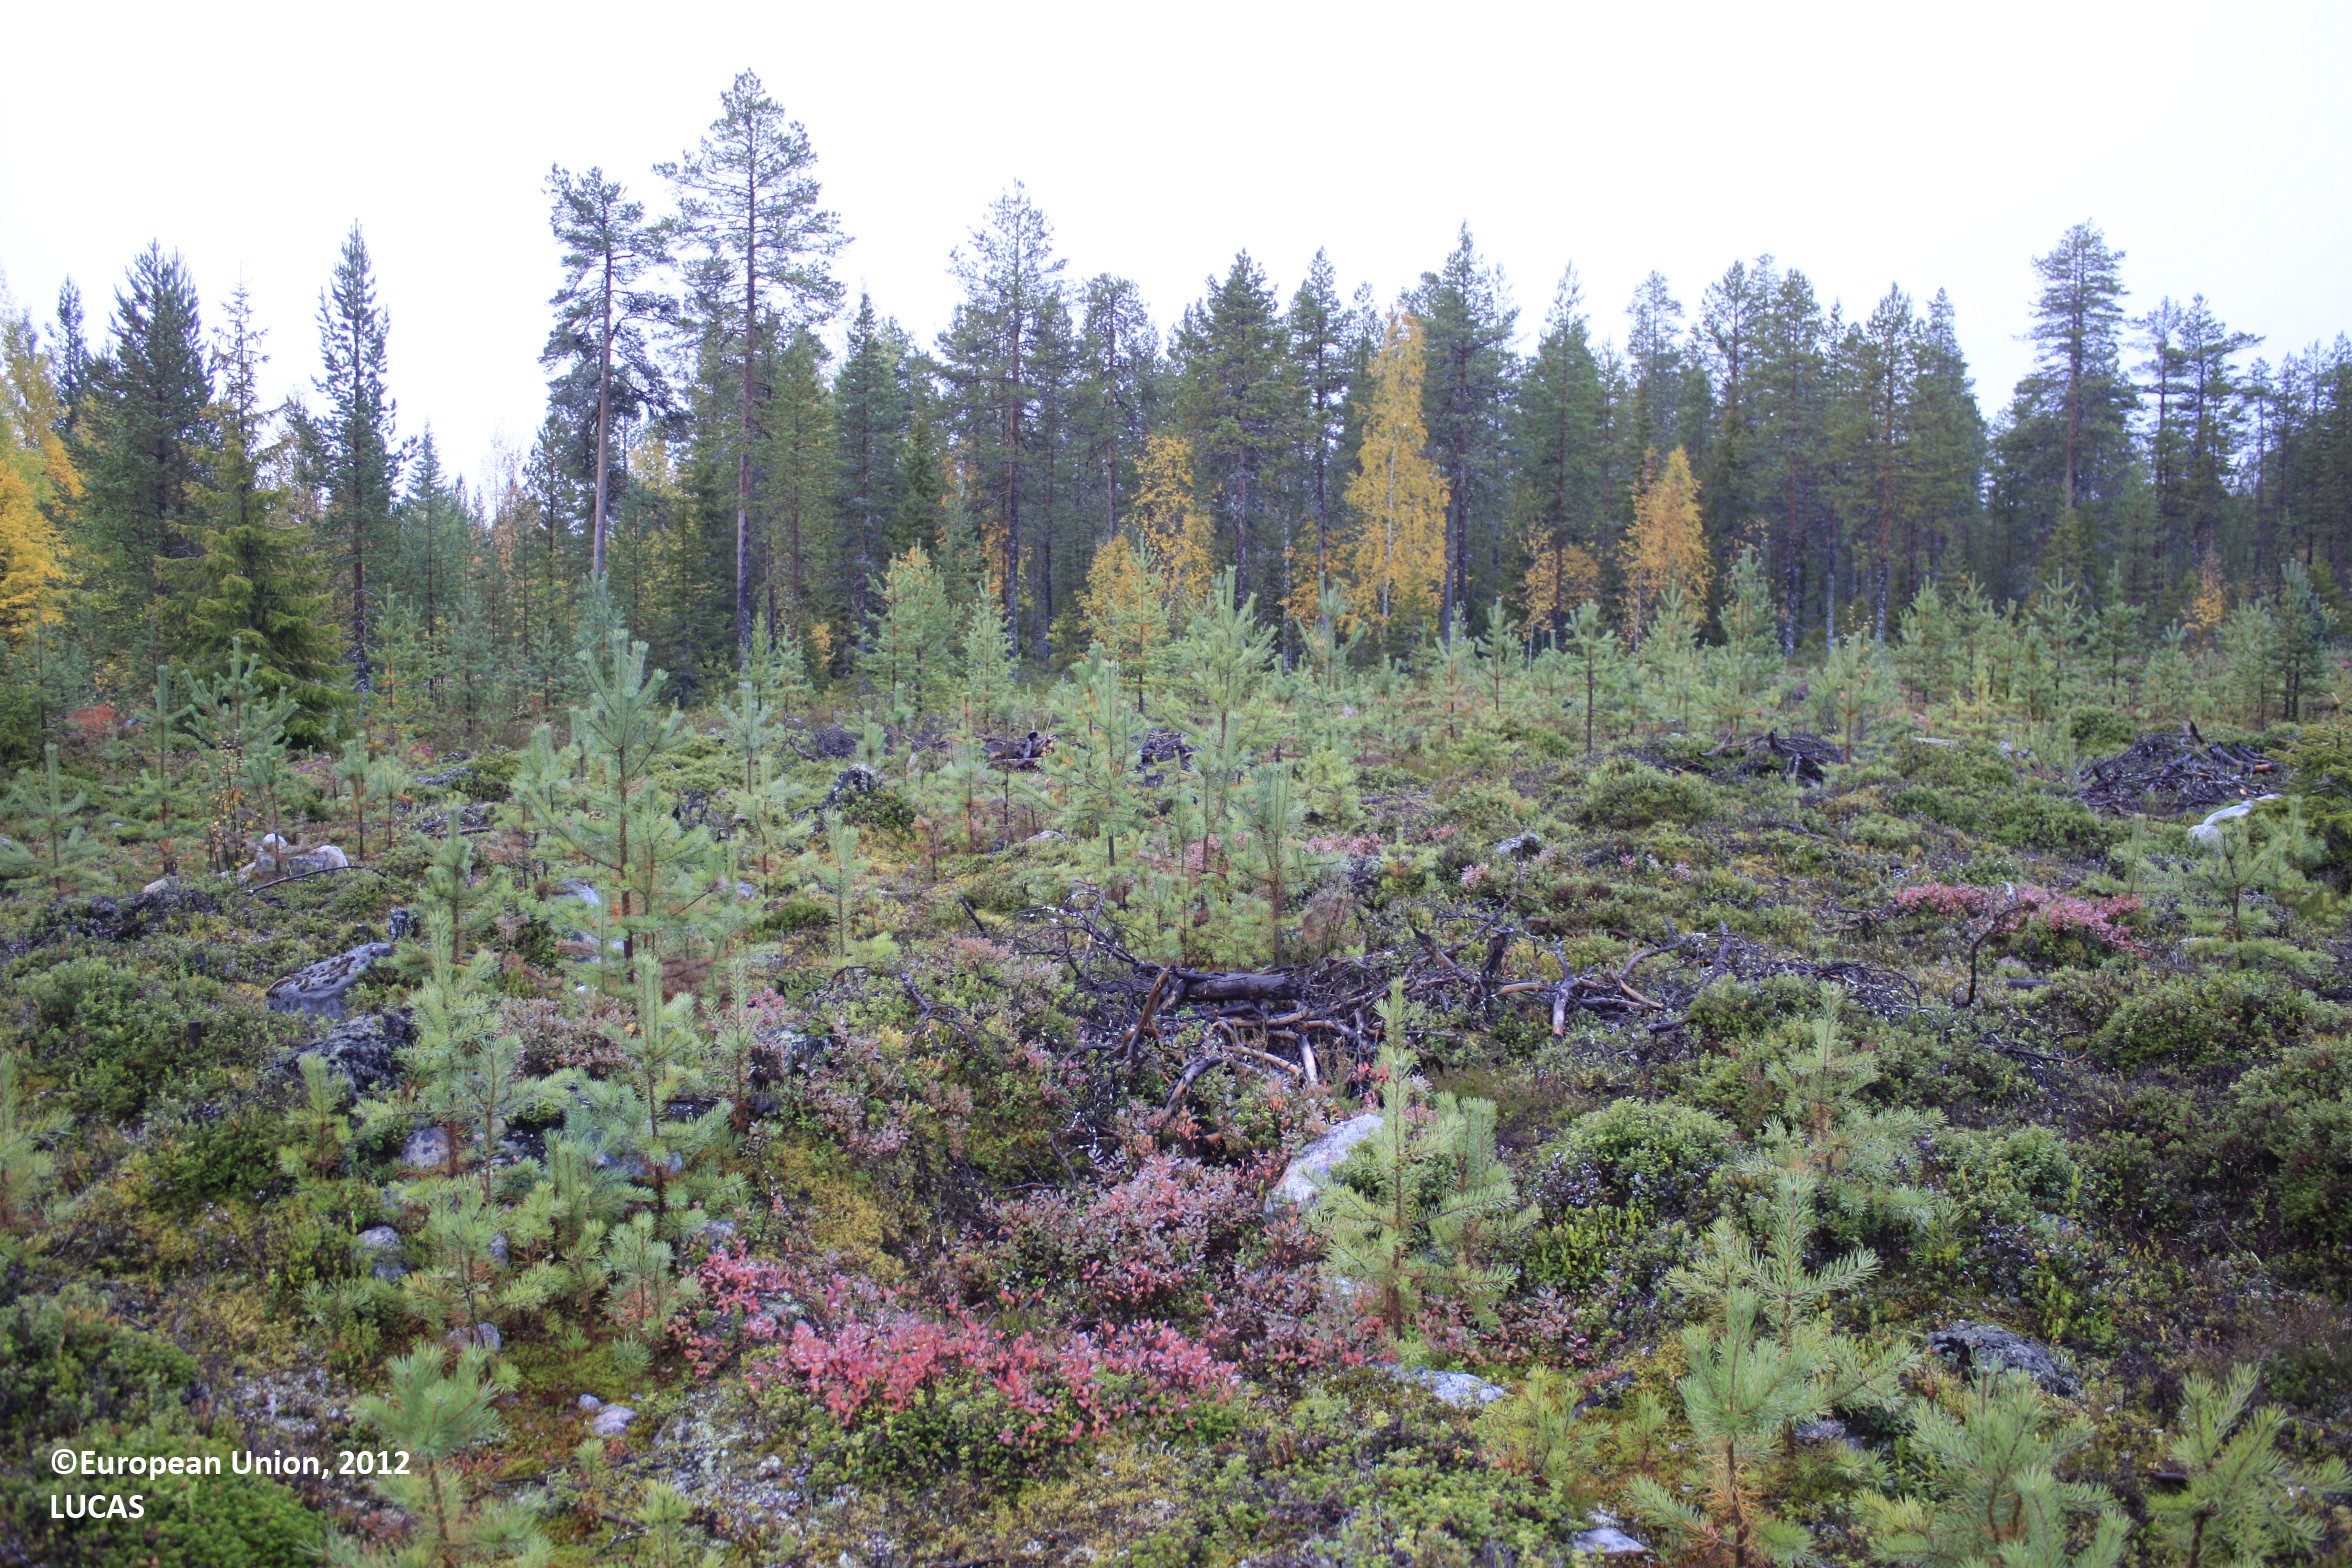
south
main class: Woodland
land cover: Pine dominated coniferous woodland
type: boreal forest
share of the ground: 10 - 25 %
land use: Forestry
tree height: < 5 m
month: September
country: FI
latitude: 66.0205
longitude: 26.7943
